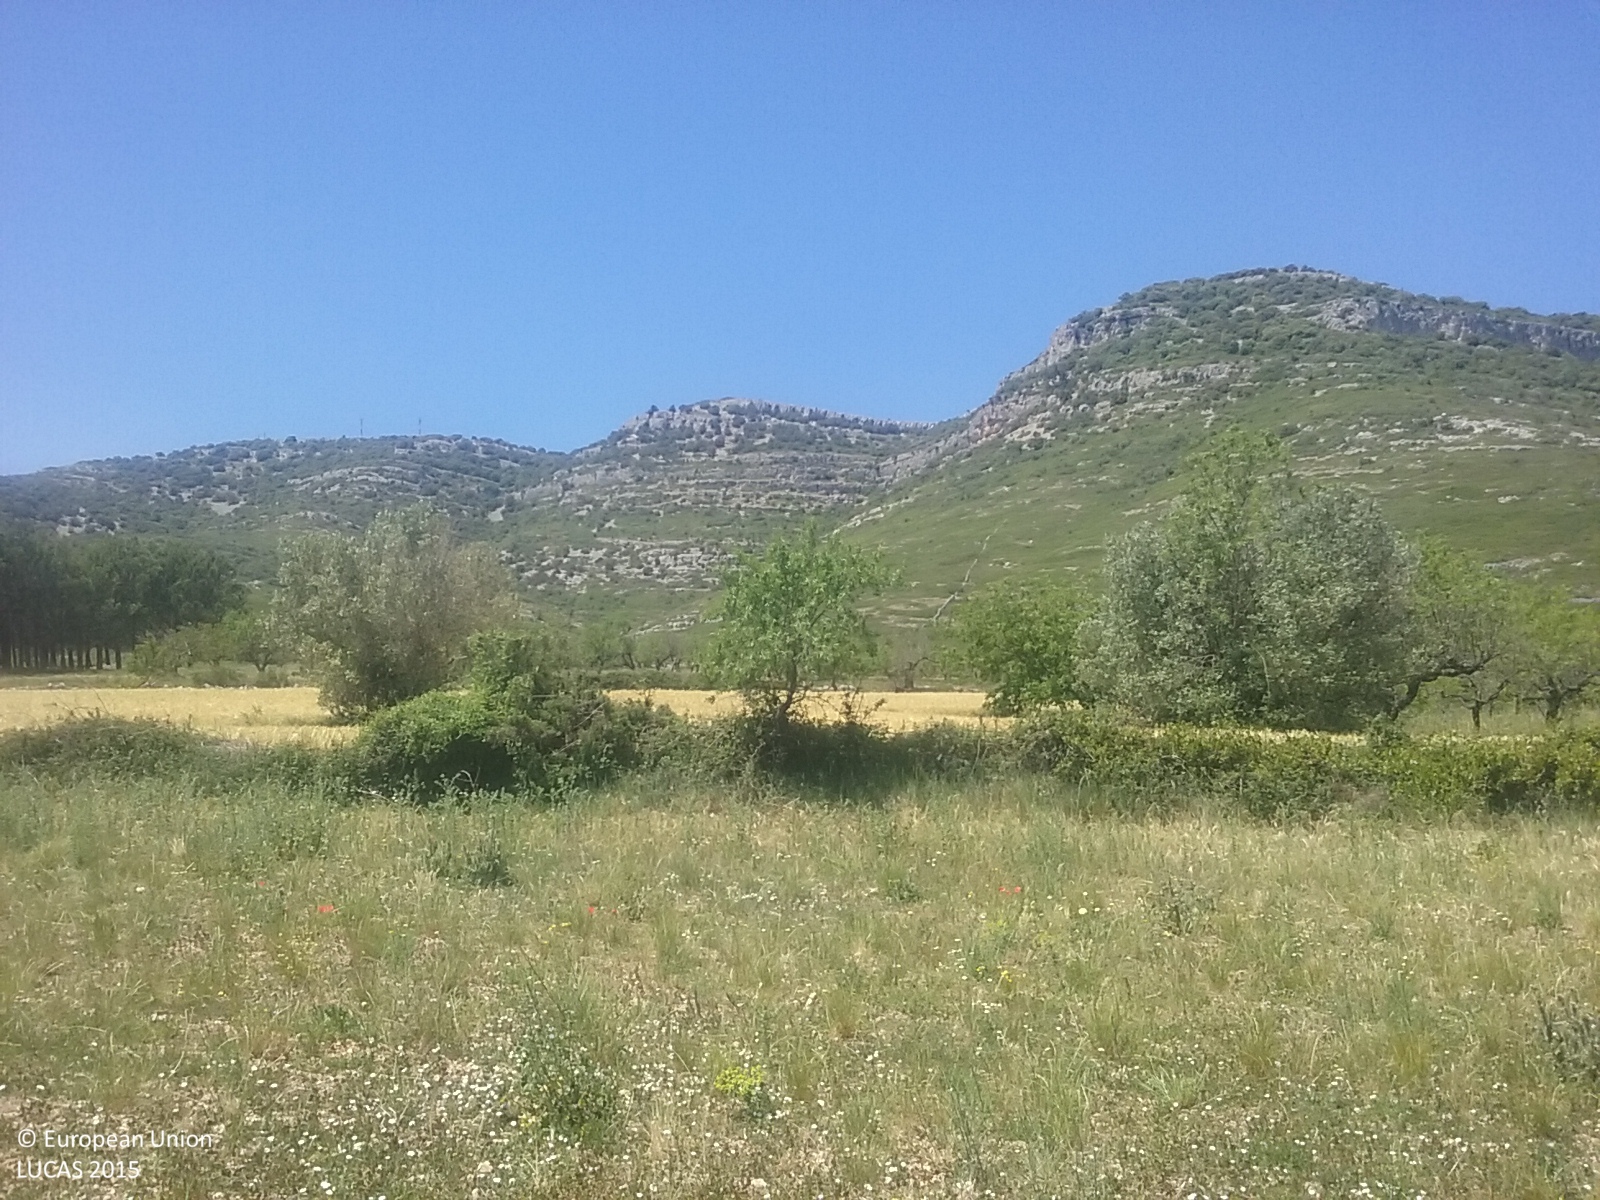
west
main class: Grassland
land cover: Spontaneously vegetated surfaces
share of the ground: > 75 %
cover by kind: herbaceous plants 95 %
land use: Fallow land
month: May
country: ES
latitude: 40.5043
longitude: 0.0229
